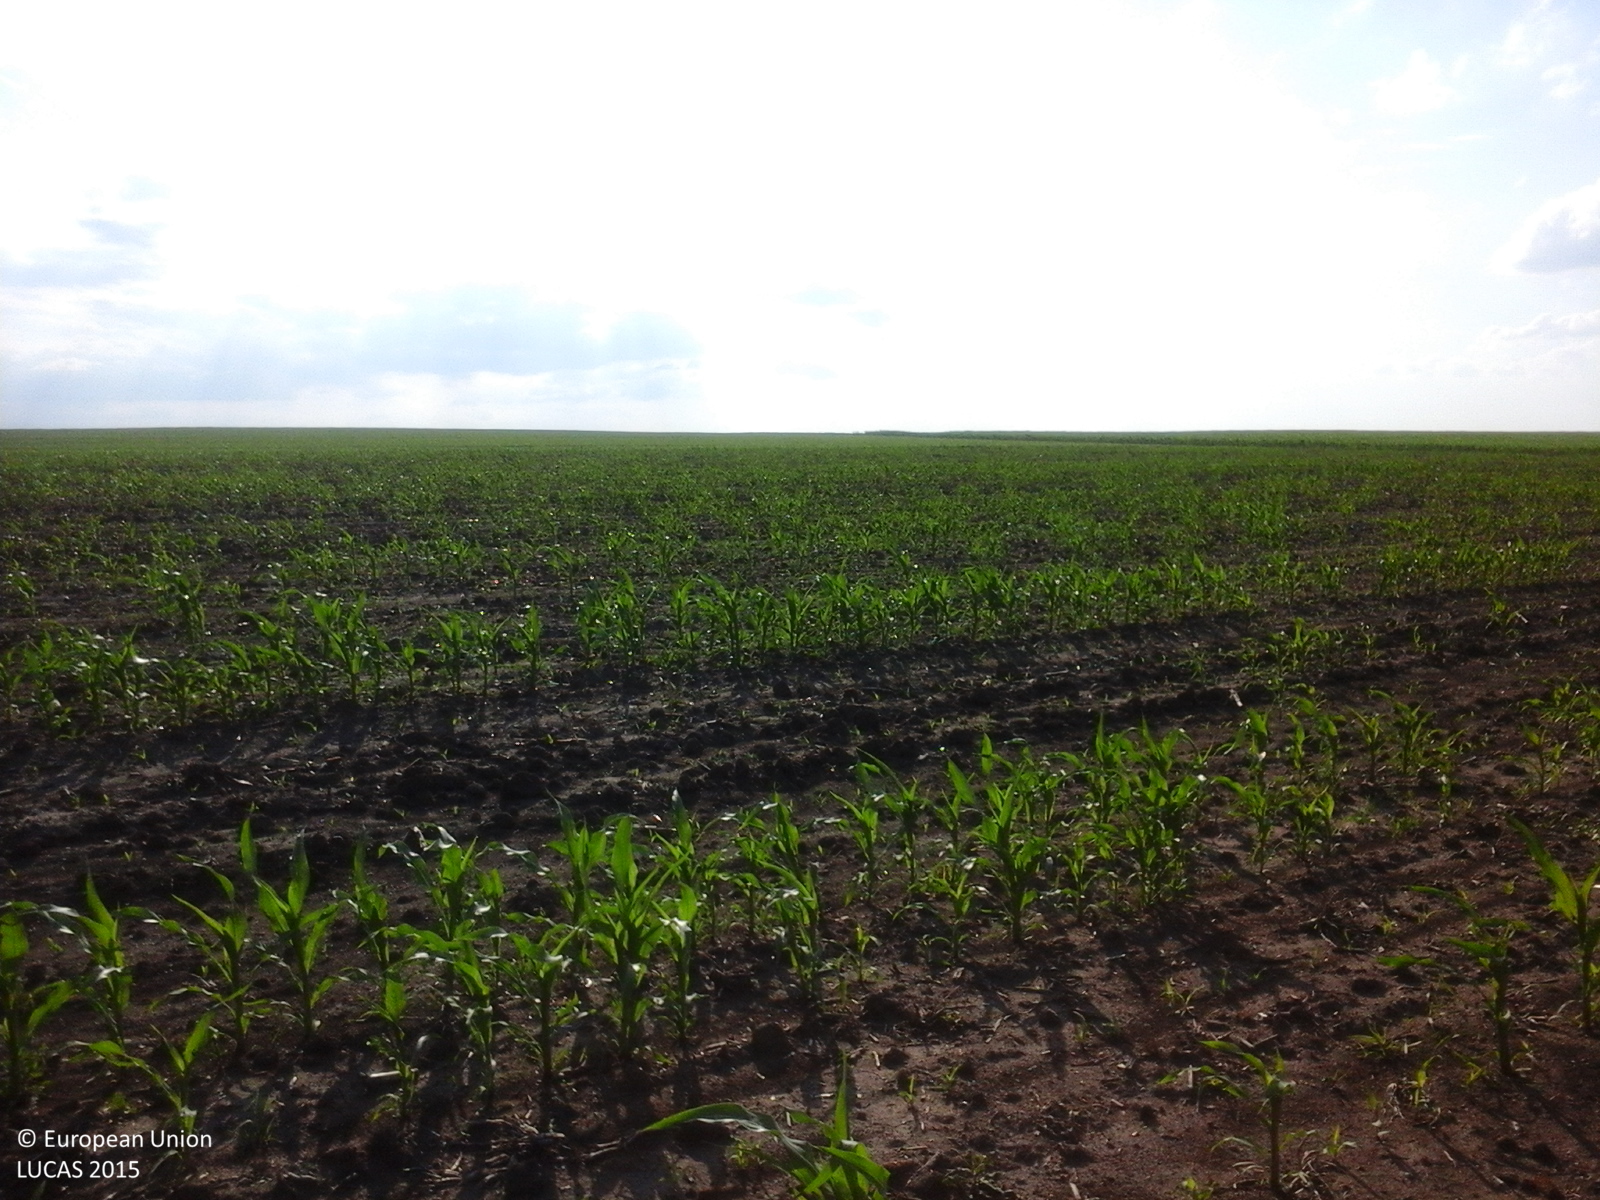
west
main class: Cropland
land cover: Maize
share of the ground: 10 - 25 %
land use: Agriculture (excluding fallow land and kitchen gardens)
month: June
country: RO
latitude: 47.8654
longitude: 26.5210
